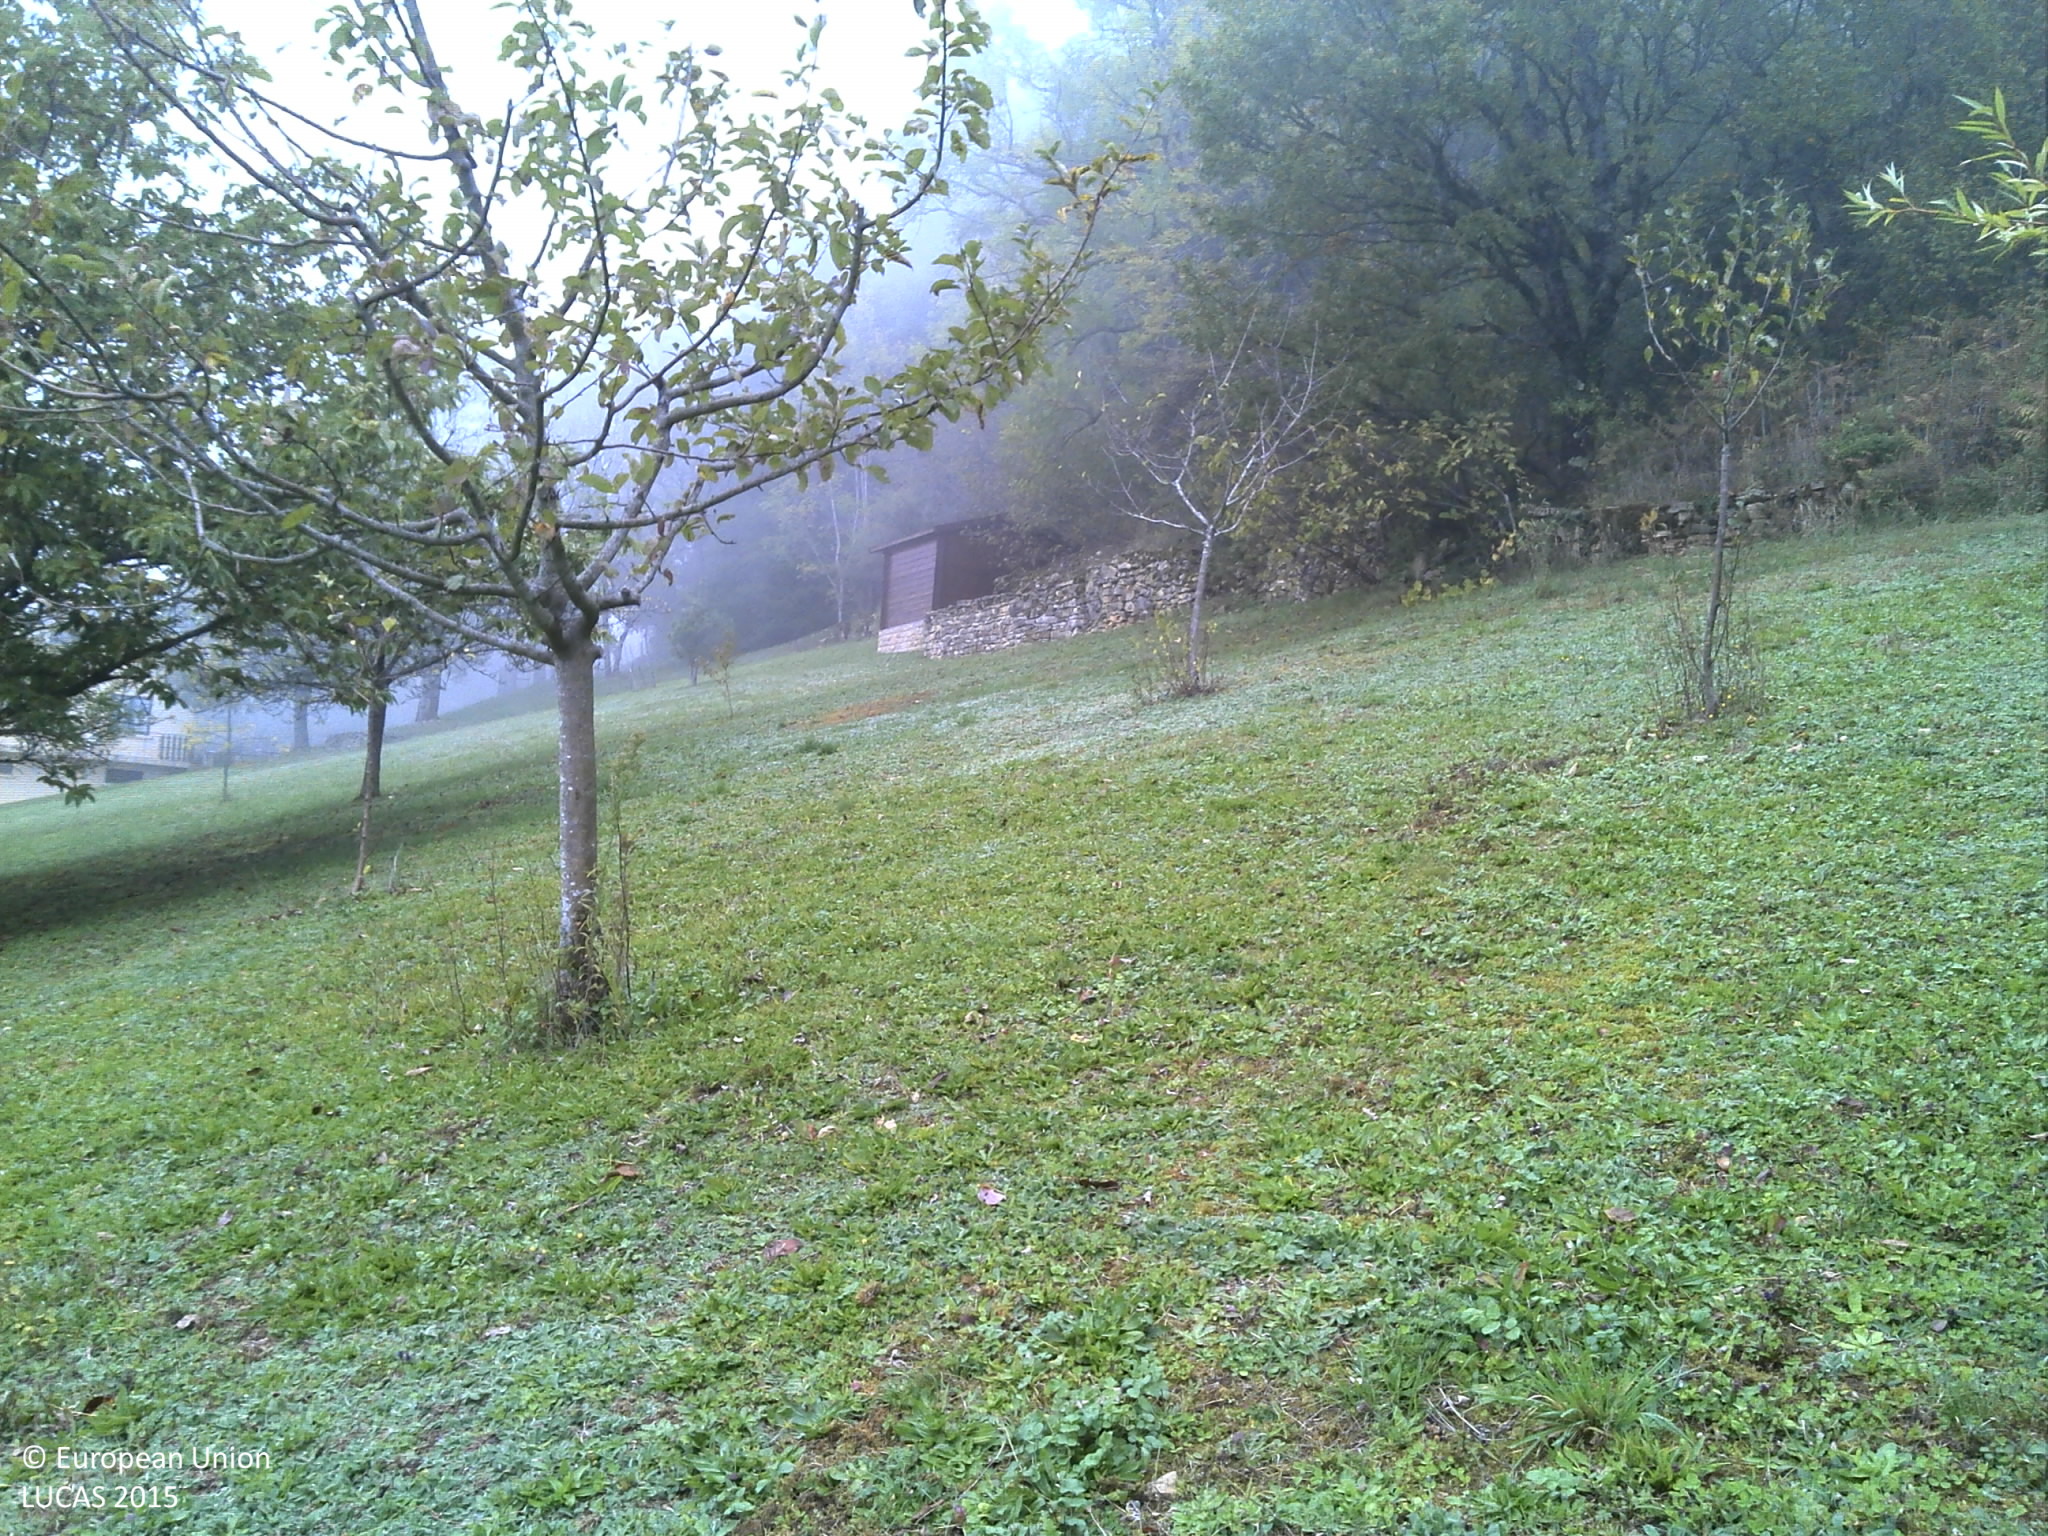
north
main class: Cropland
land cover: Apple fruit
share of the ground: 10 - 25 %
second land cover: Grassland without tree/shrub cover
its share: > 75 %
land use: Kitchen garden
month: October
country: FR
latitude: 46.3769
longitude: 5.3614
